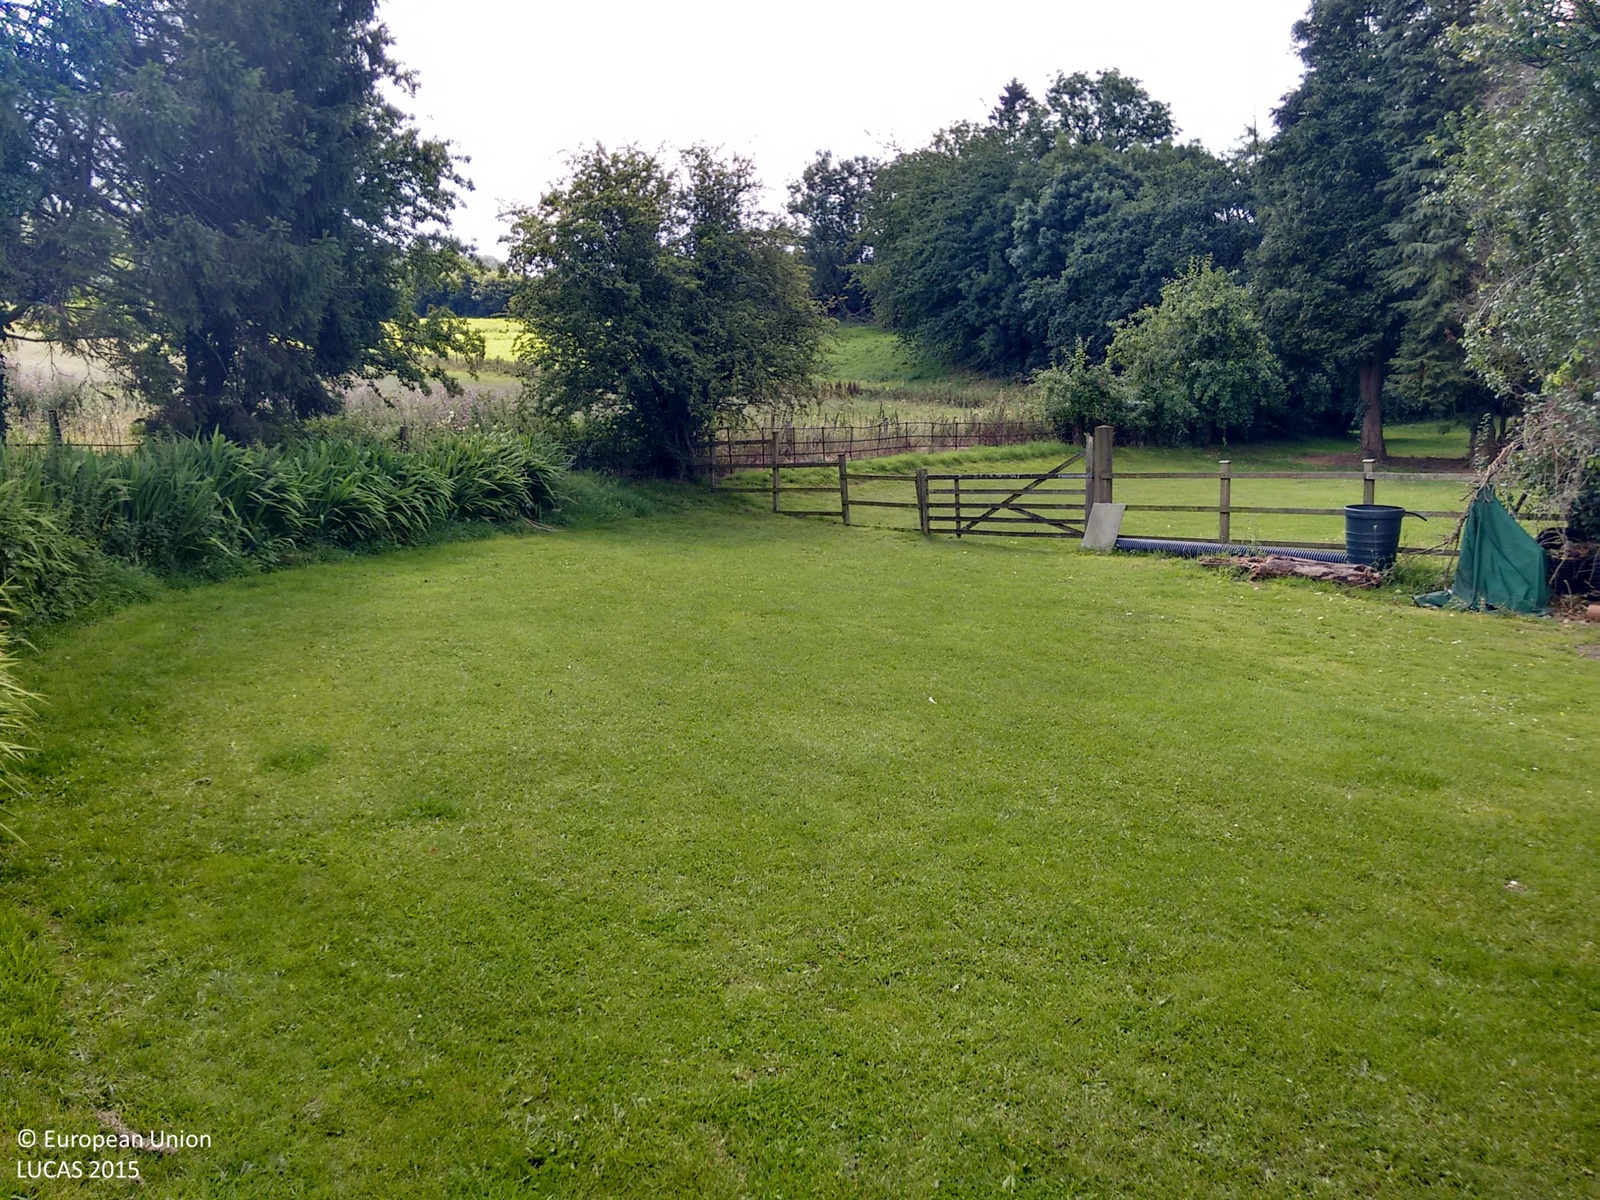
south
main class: Grassland
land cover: Grassland without tree/shrub cover
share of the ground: > 75 %
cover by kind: herbaceous plants 100 %
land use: Agriculture (excluding fallow land and kitchen gardens)
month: August
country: GB
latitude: 50.8216
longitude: -3.1512
